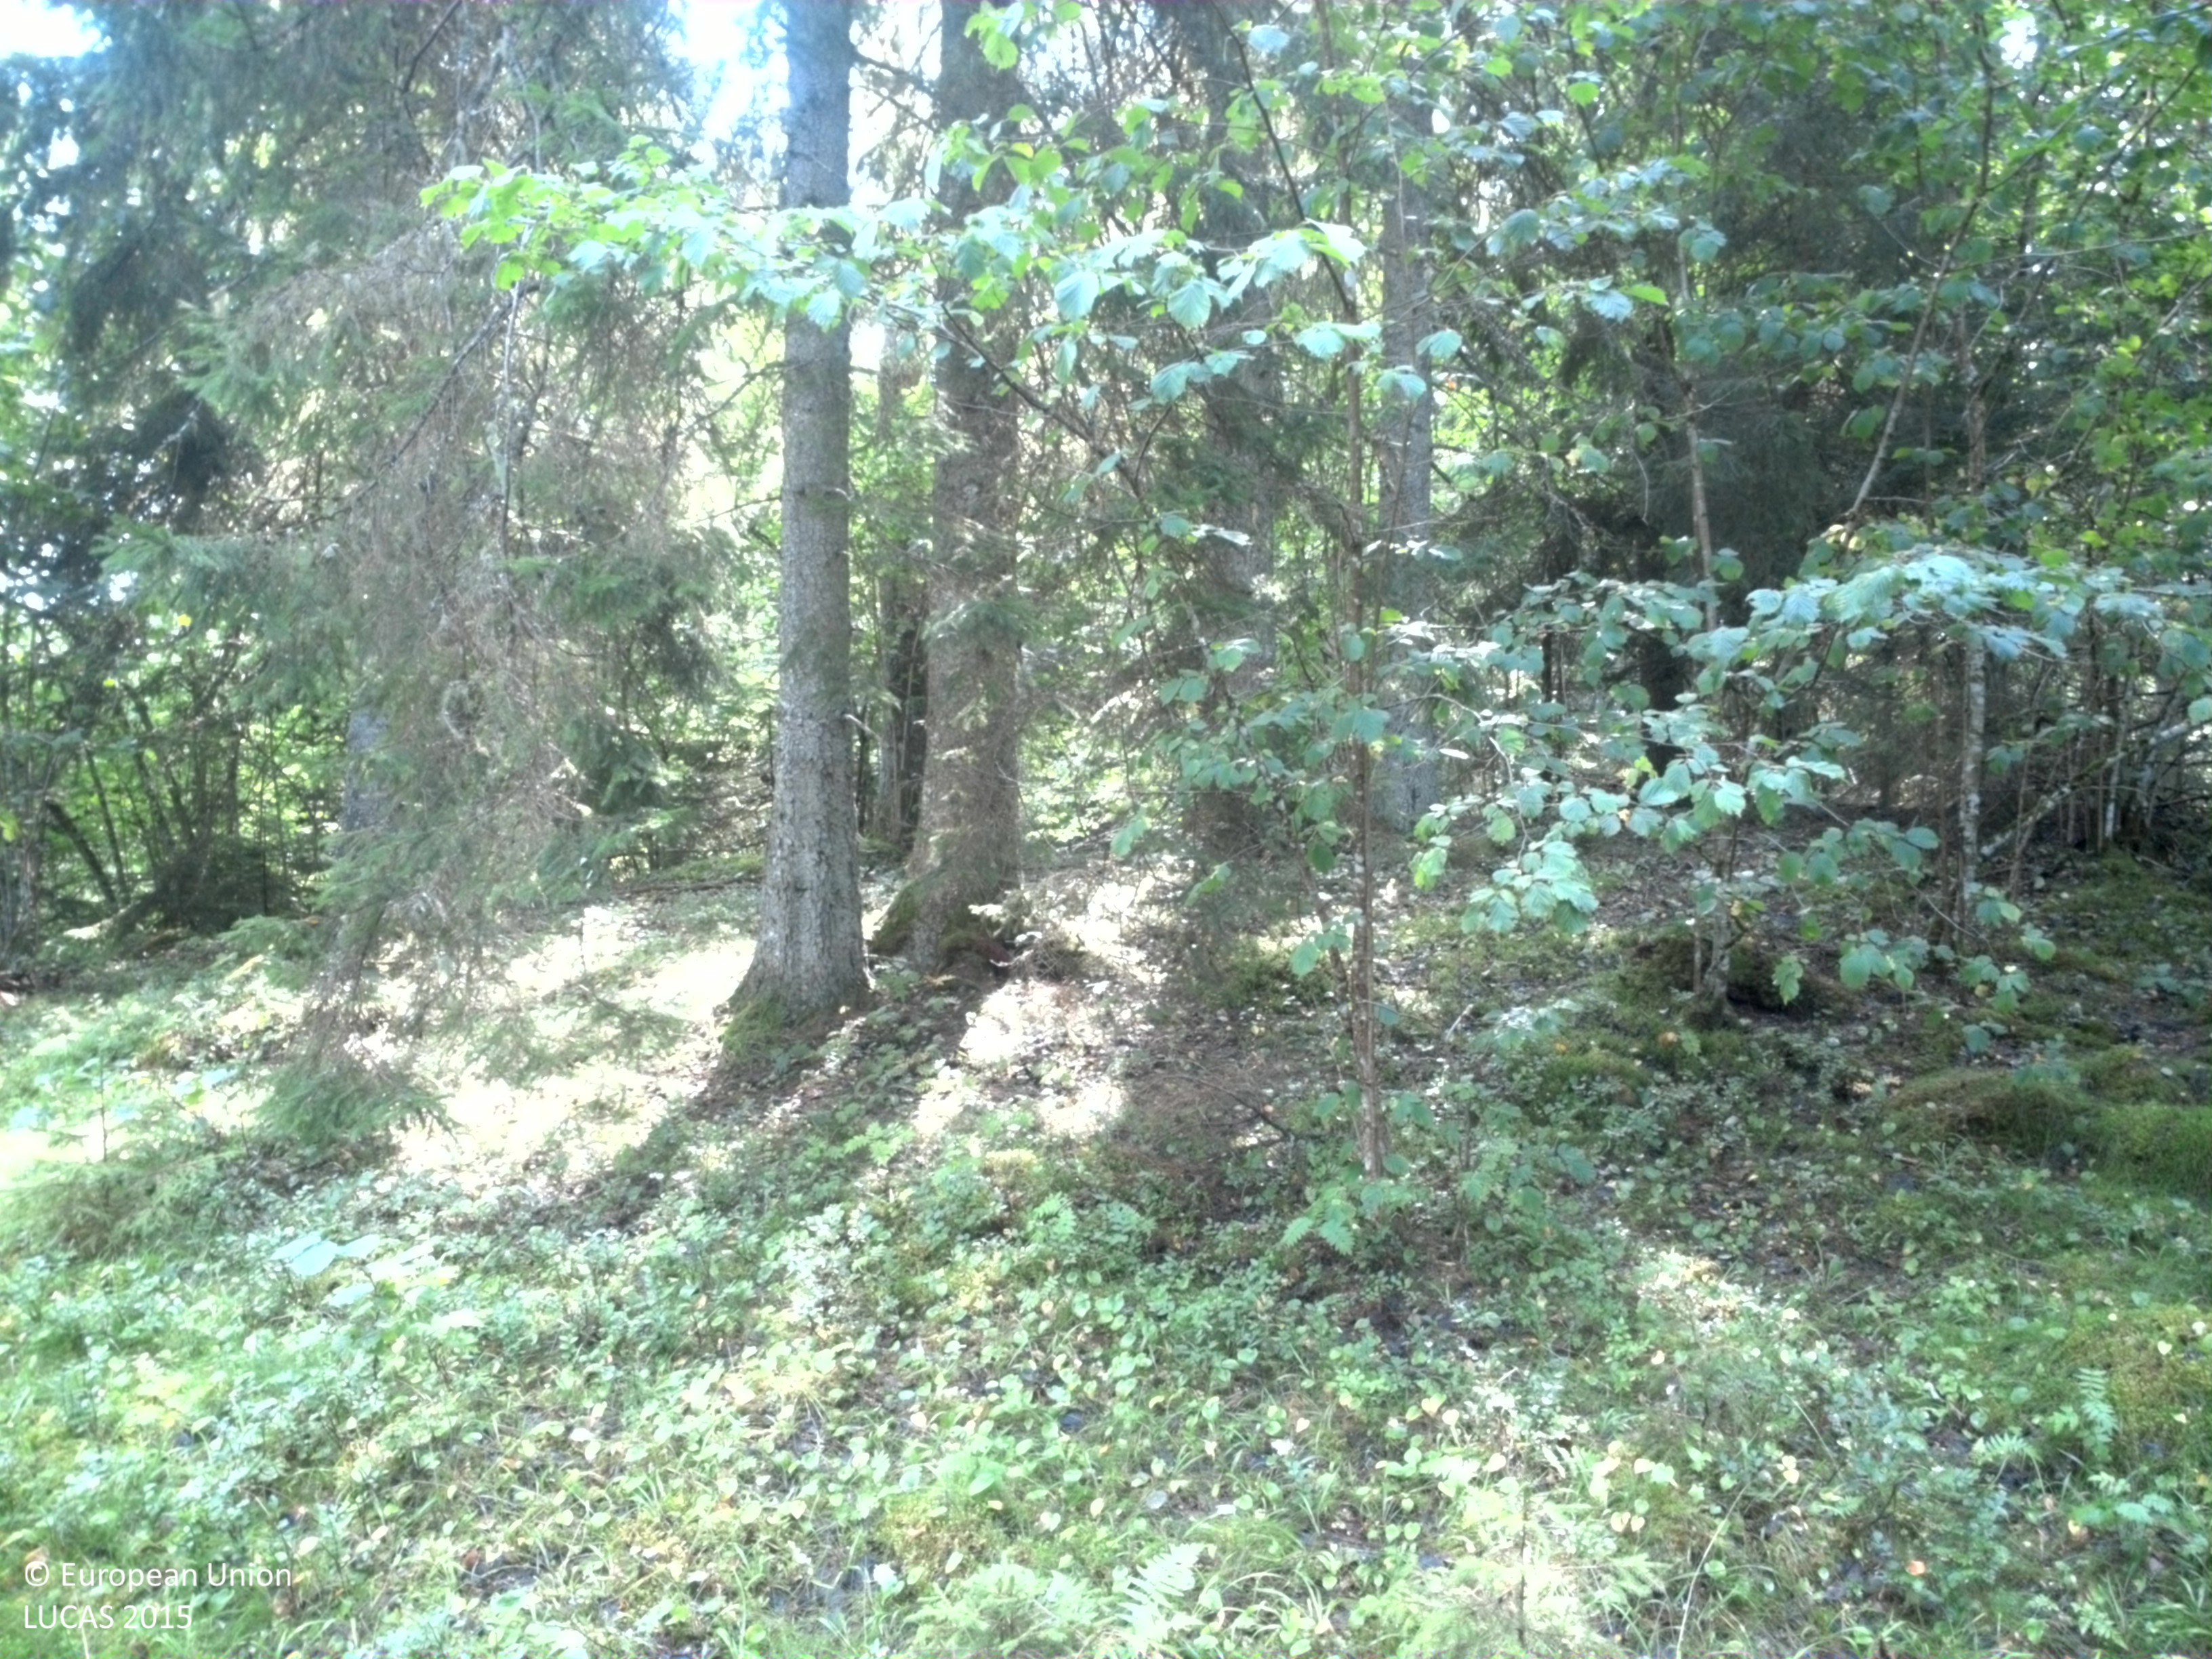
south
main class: Woodland
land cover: Spruce dominated mixed woodland
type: boreal forest
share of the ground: 25 - 50 %
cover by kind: coniferous forest trees 25 %, broadleaved forest trees 25 %, herbaceous plants 20 %, lichens and mosses 20 %, shrubs 10 %
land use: Agriculture (excluding fallow land and kitchen gardens)
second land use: Forestry
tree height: > 5 m
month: August
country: SE
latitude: 57.9450
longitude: 13.9646
